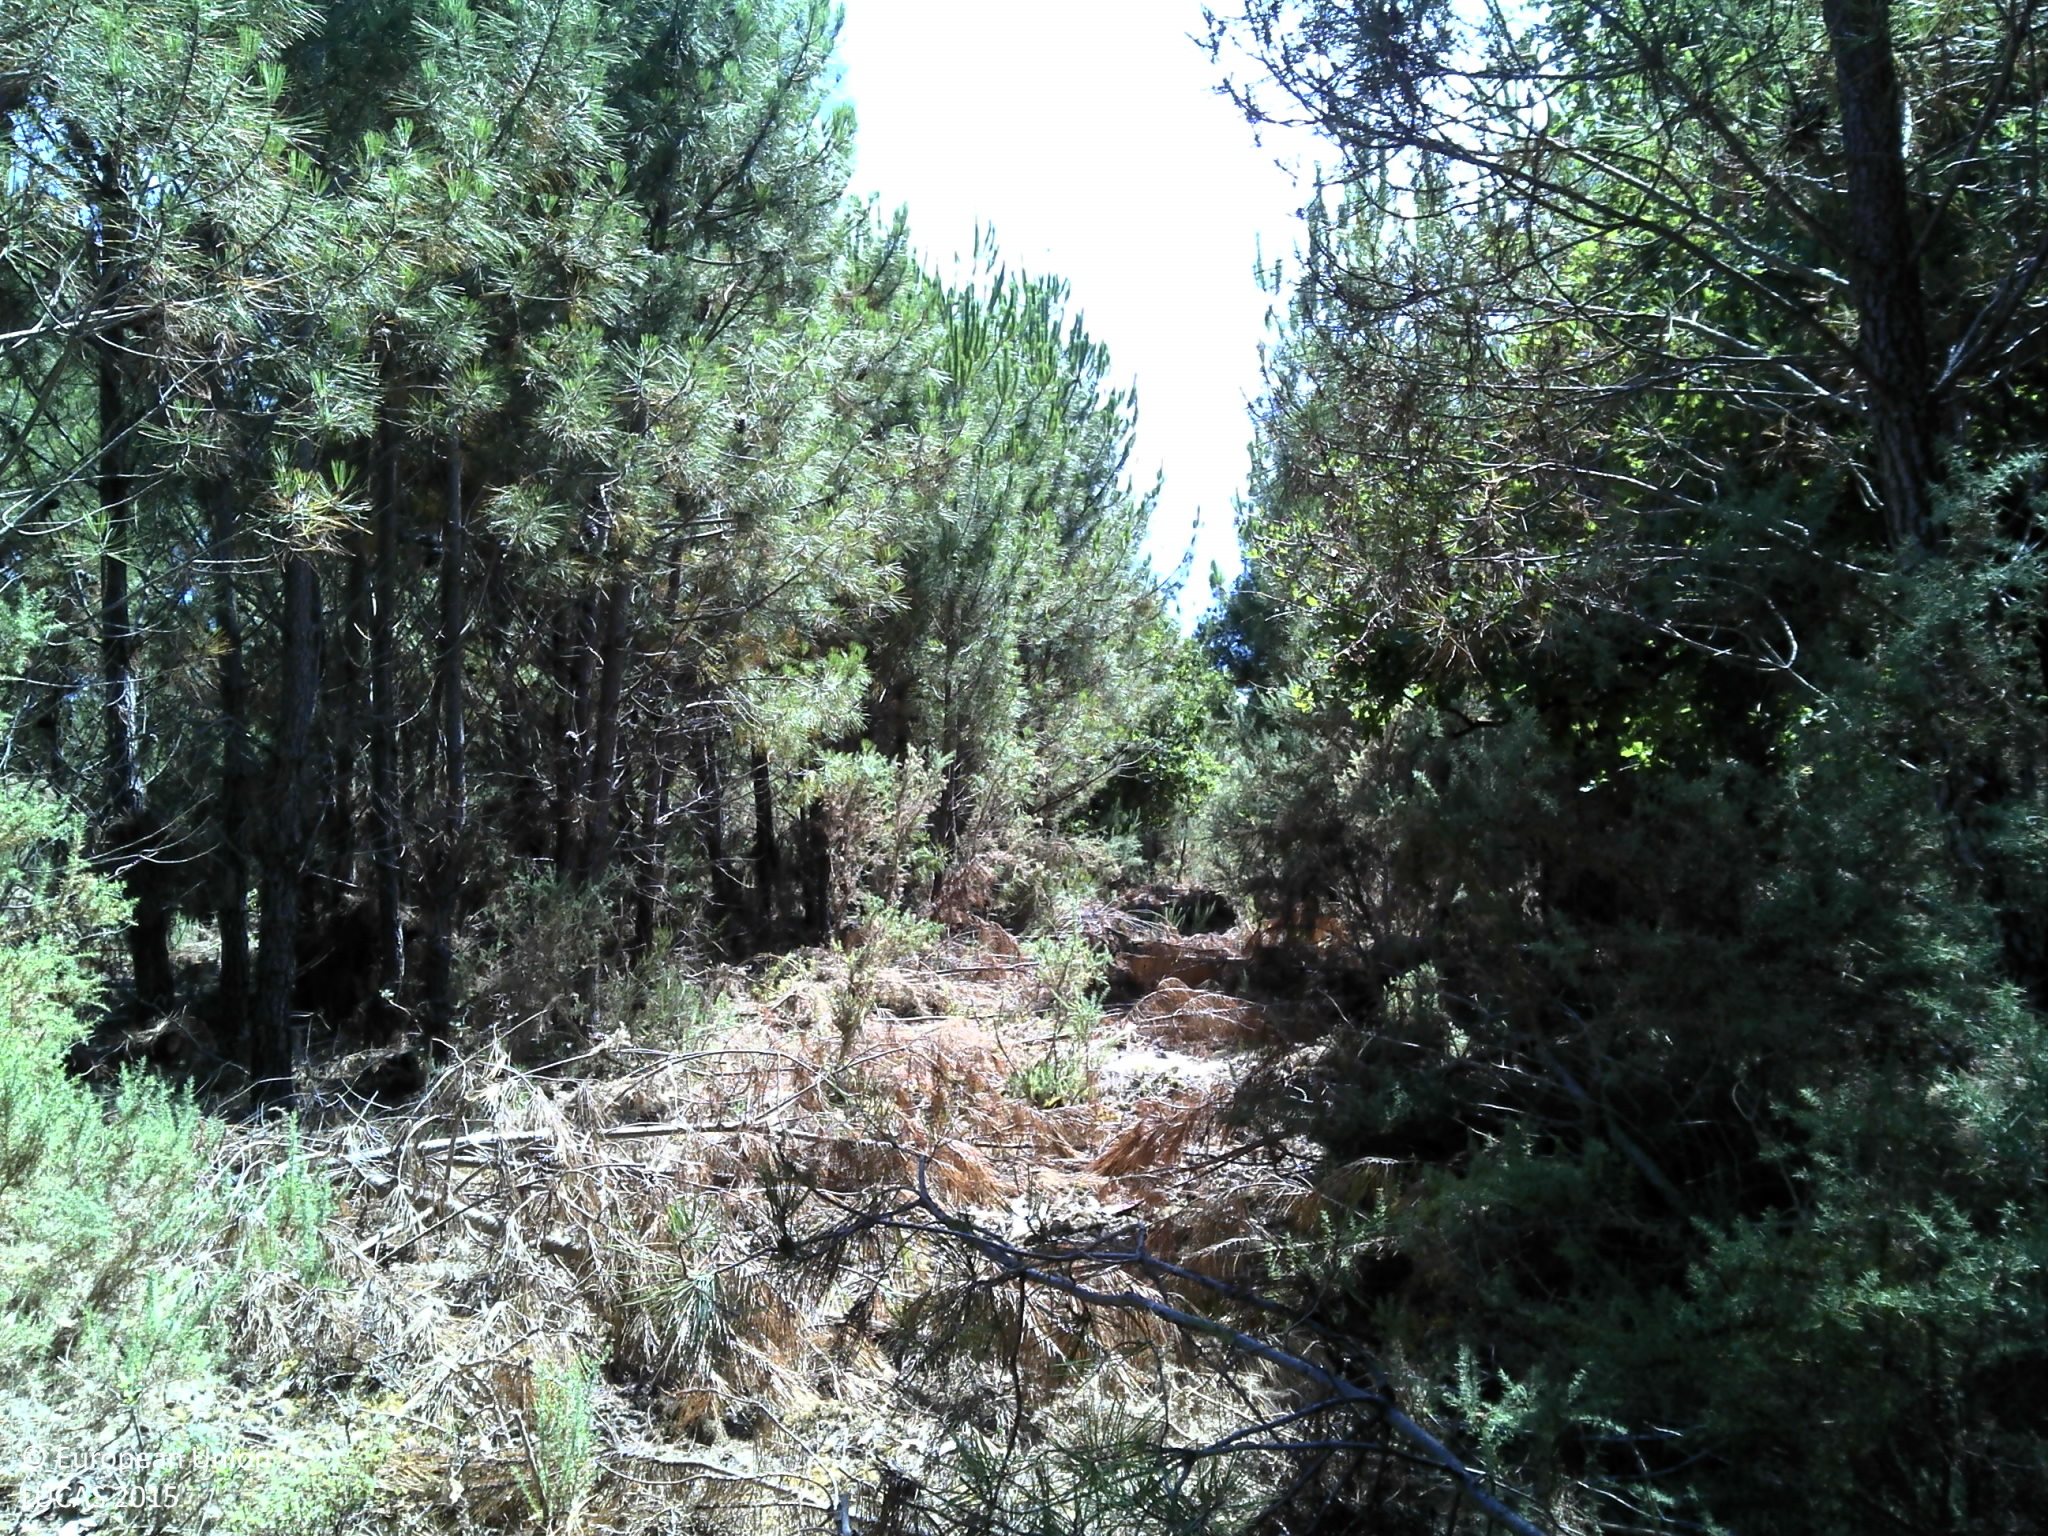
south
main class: Woodland
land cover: Pine dominated coniferous woodland
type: coniferous forest of the mediterranean region
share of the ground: > 75 %
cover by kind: coniferous forest trees 75 %, shrubs 15 %, unconsolidated bare surface 10 %
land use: Forestry
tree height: < 5 m
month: July
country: FR
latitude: 45.2954
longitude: -1.1335
